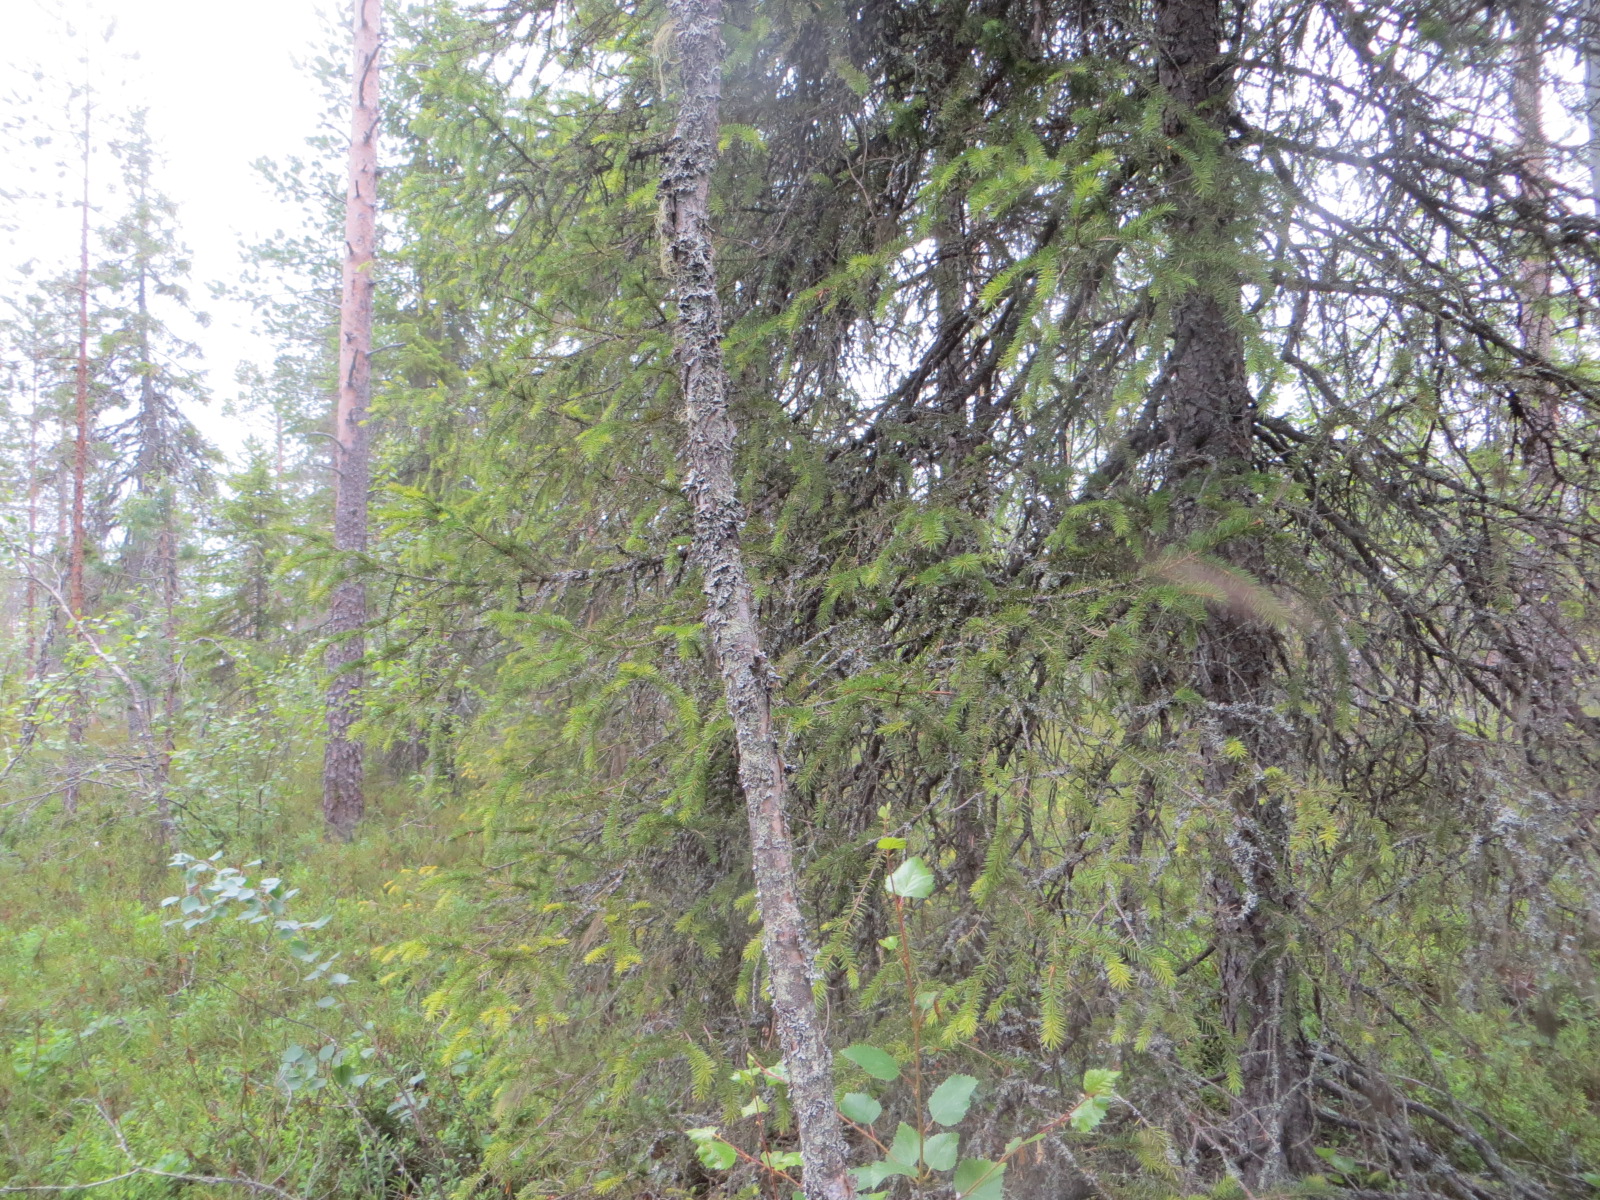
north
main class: Woodland
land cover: Pine dominated coniferous woodland
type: boreal forest
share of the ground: 50 - 75 %
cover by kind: coniferous forest trees 50 %, shrubs 40 %, broadleaved forest trees 10 %
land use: Semi-natural and natural areas not in use
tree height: > 5 m
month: July
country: FI
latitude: 65.8726
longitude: 25.2608
